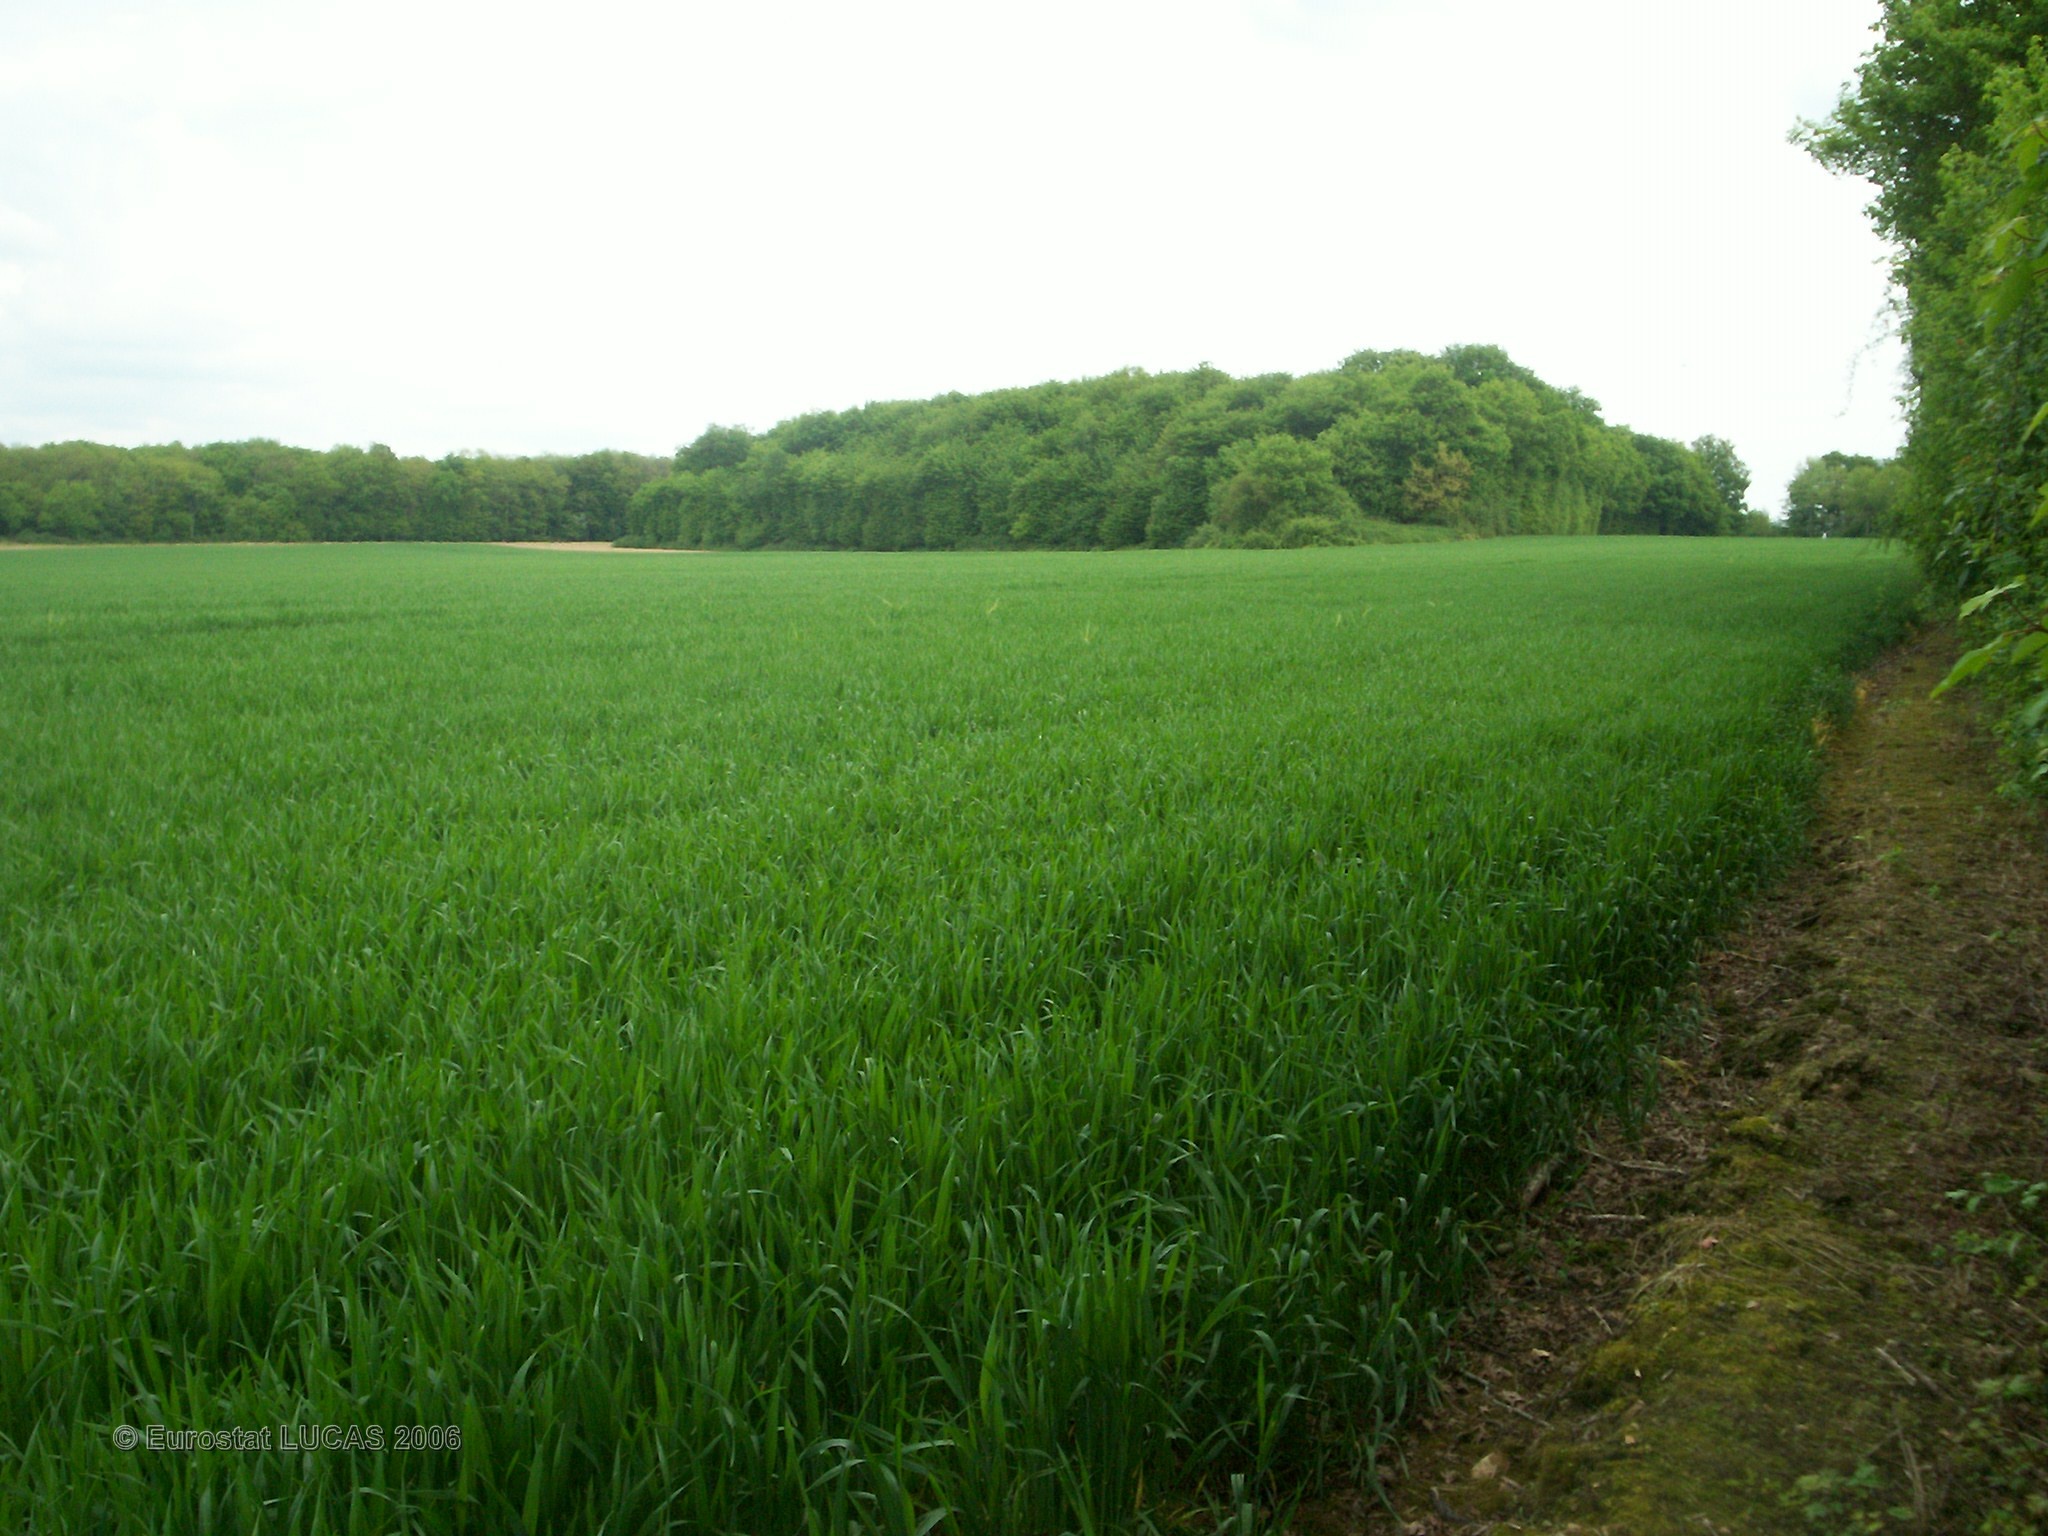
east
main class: Grassland
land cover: Grassland without tree/shrub cover
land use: Agriculture (excluding fallow land and kitchen gardens)
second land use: Sport
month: May
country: FR
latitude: 47.6921
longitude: 2.9720
